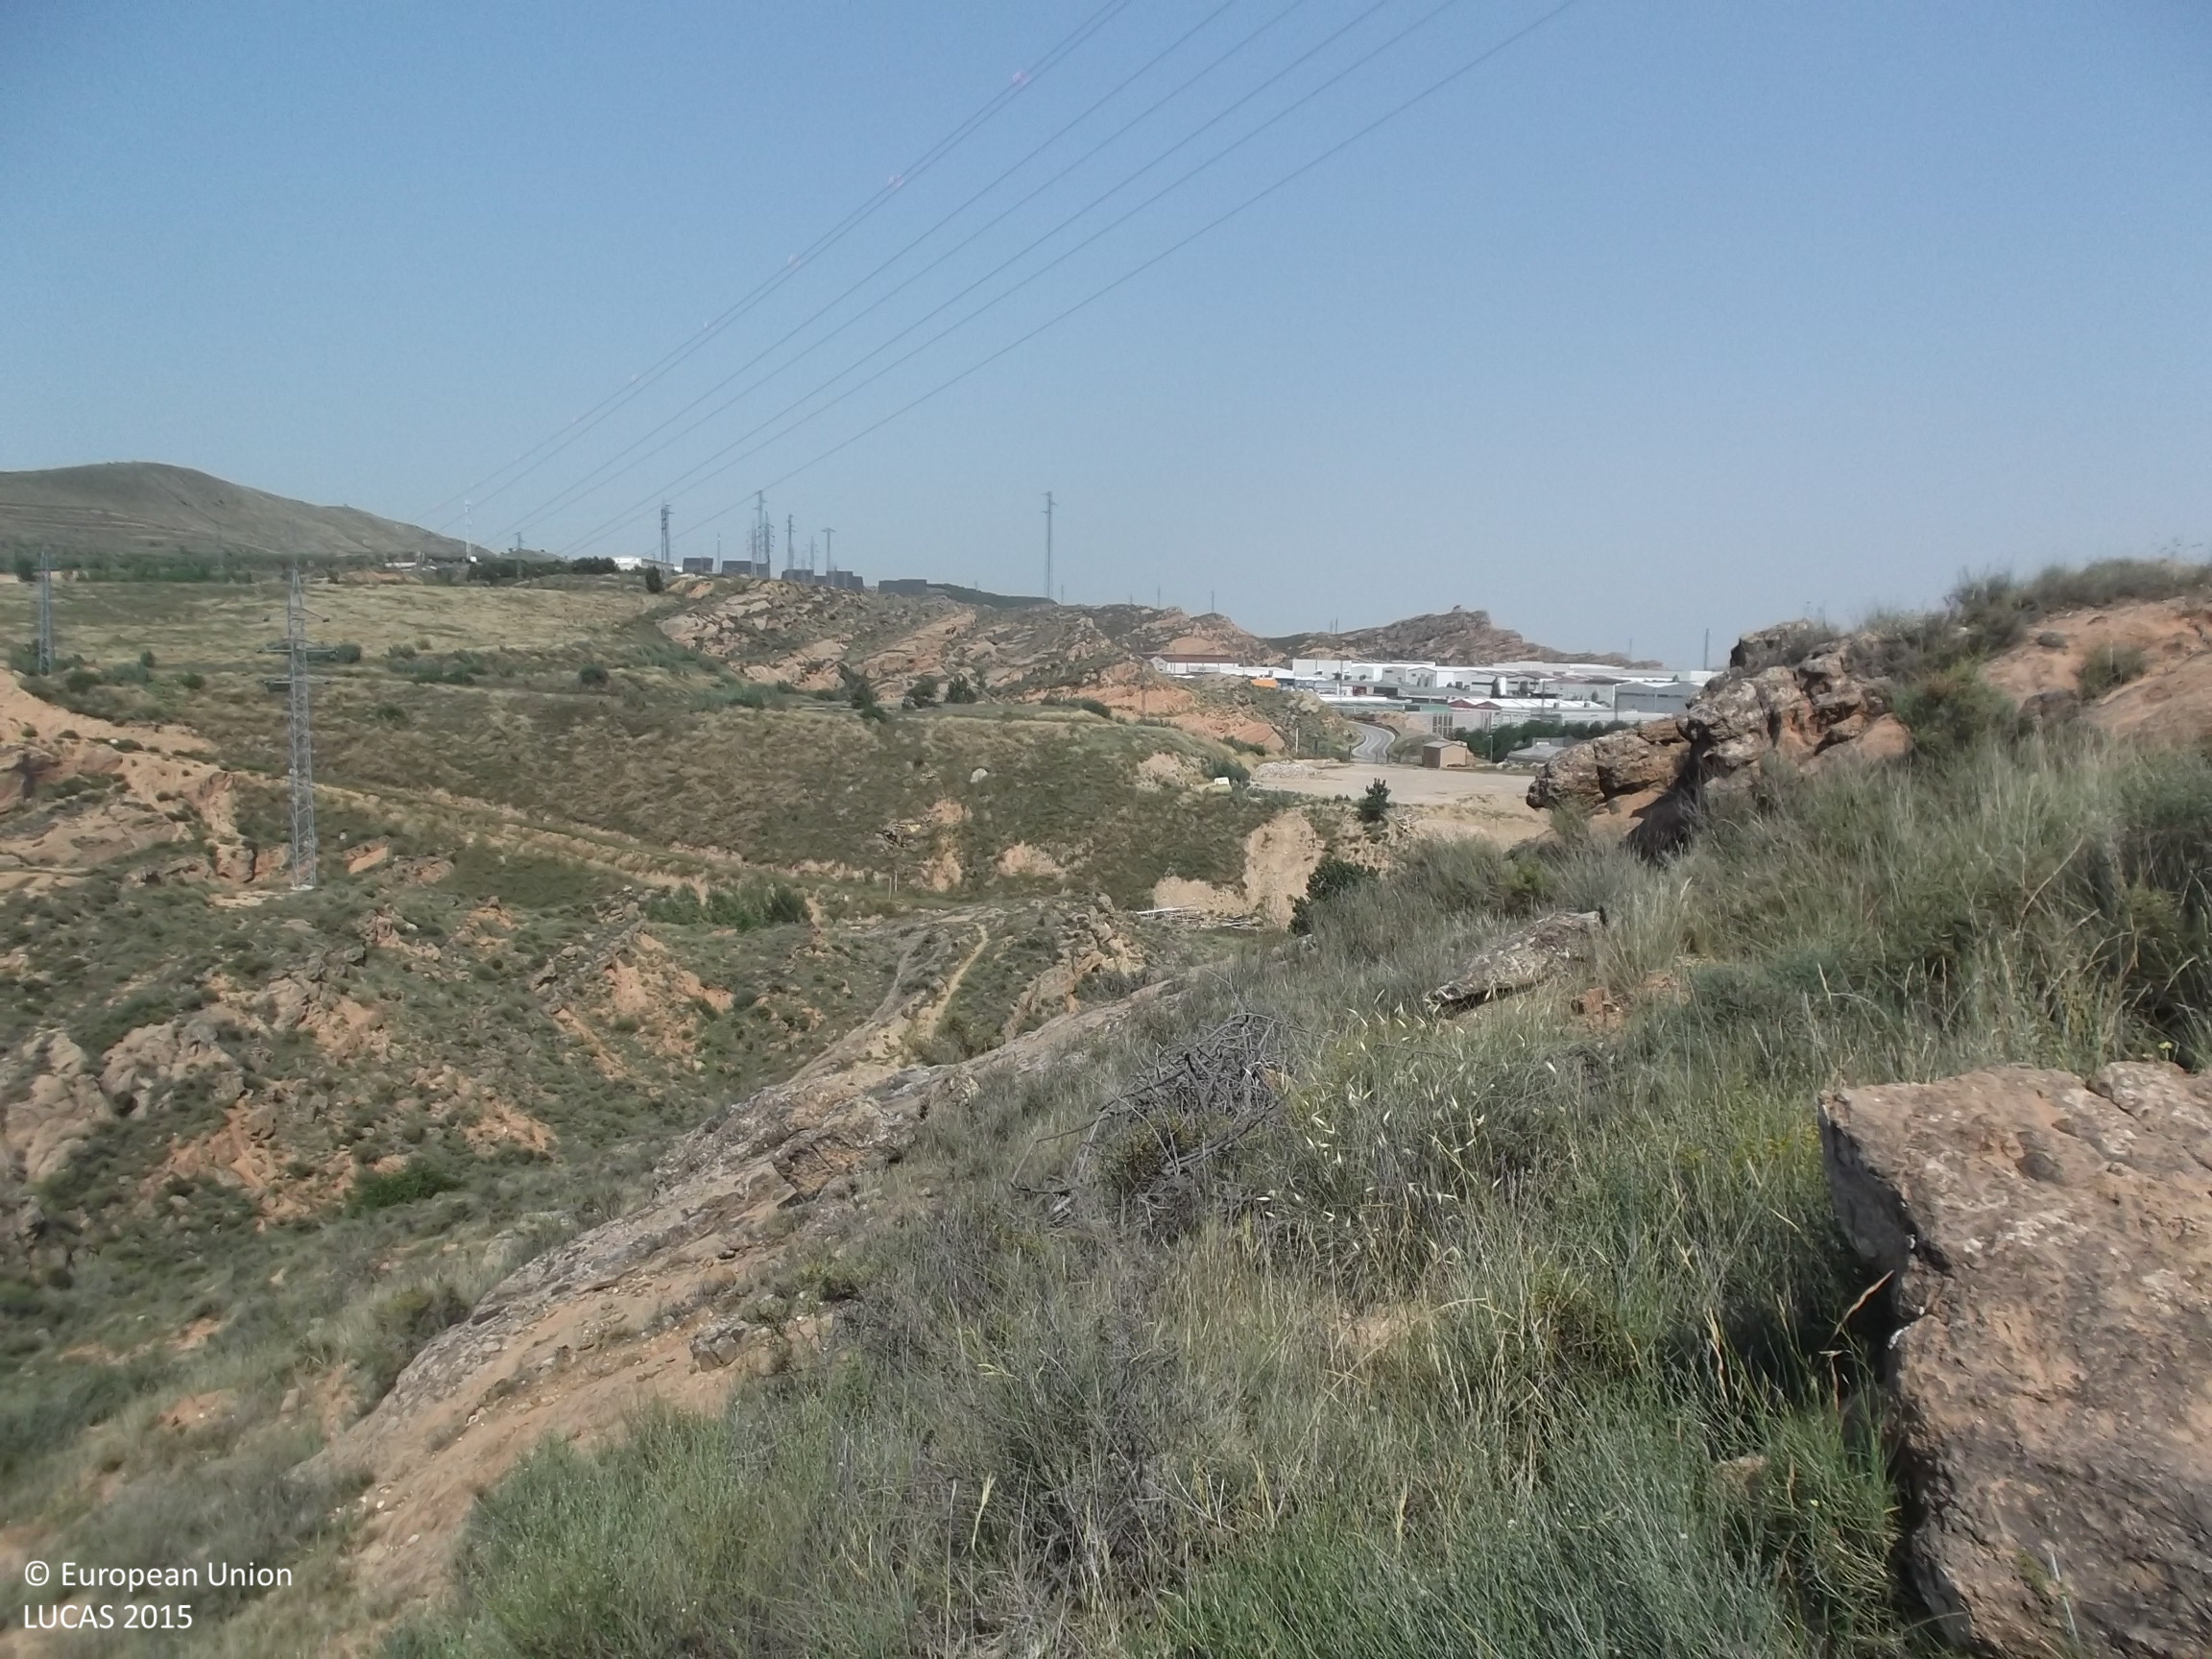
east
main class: Shrubland
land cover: Shrubland without tree cover
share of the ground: 50 - 75 %
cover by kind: shrubs 60 %, herbaceous plants 30 %, unconsolidated bare surface 10 %
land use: Semi-natural and natural areas not in use
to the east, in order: Shrubland without tree cover; Electric lines; Shrubland without tree cover; Rivers and streams; Shrubland without tree cover; Artificial constructions in urban areas
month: June
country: ES
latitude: 42.2364
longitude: -2.0957
